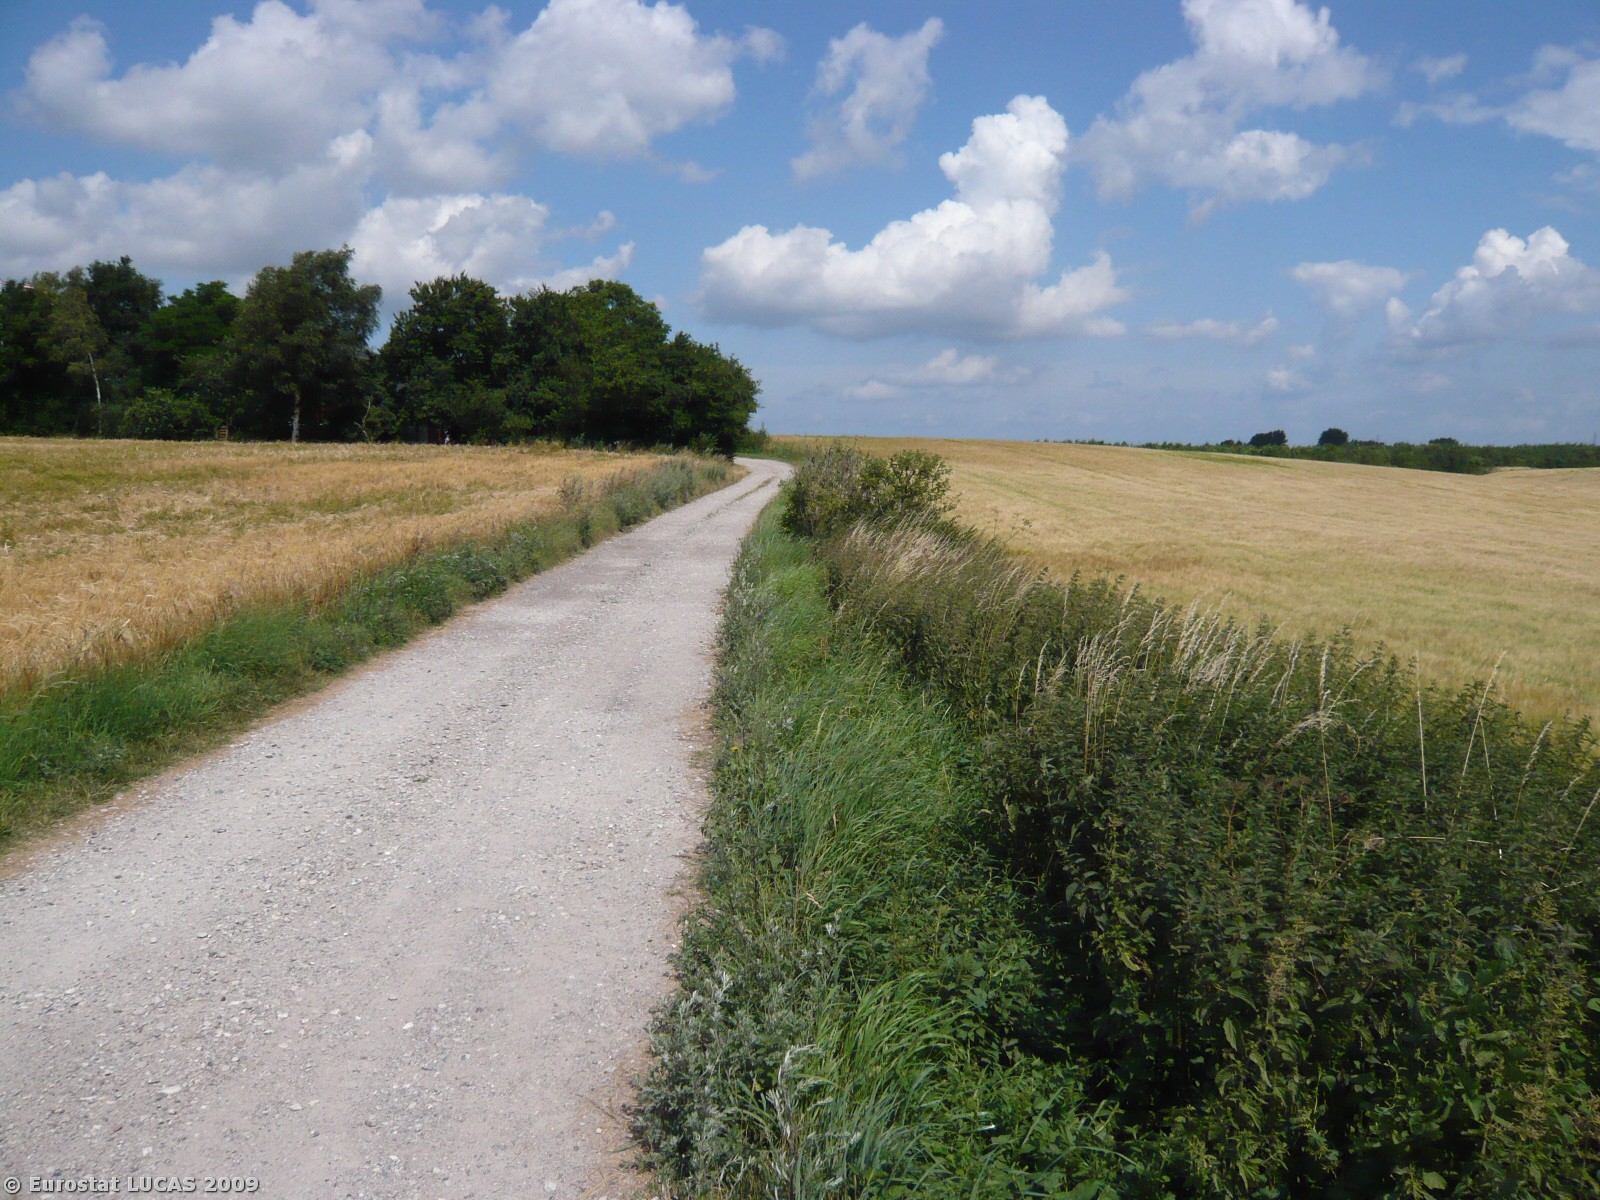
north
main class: Cropland
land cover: Barley
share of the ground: > 75 %
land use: Agriculture (excluding fallow land and kitchen gardens)
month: July
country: DK
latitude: 55.6902
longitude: 11.7641
